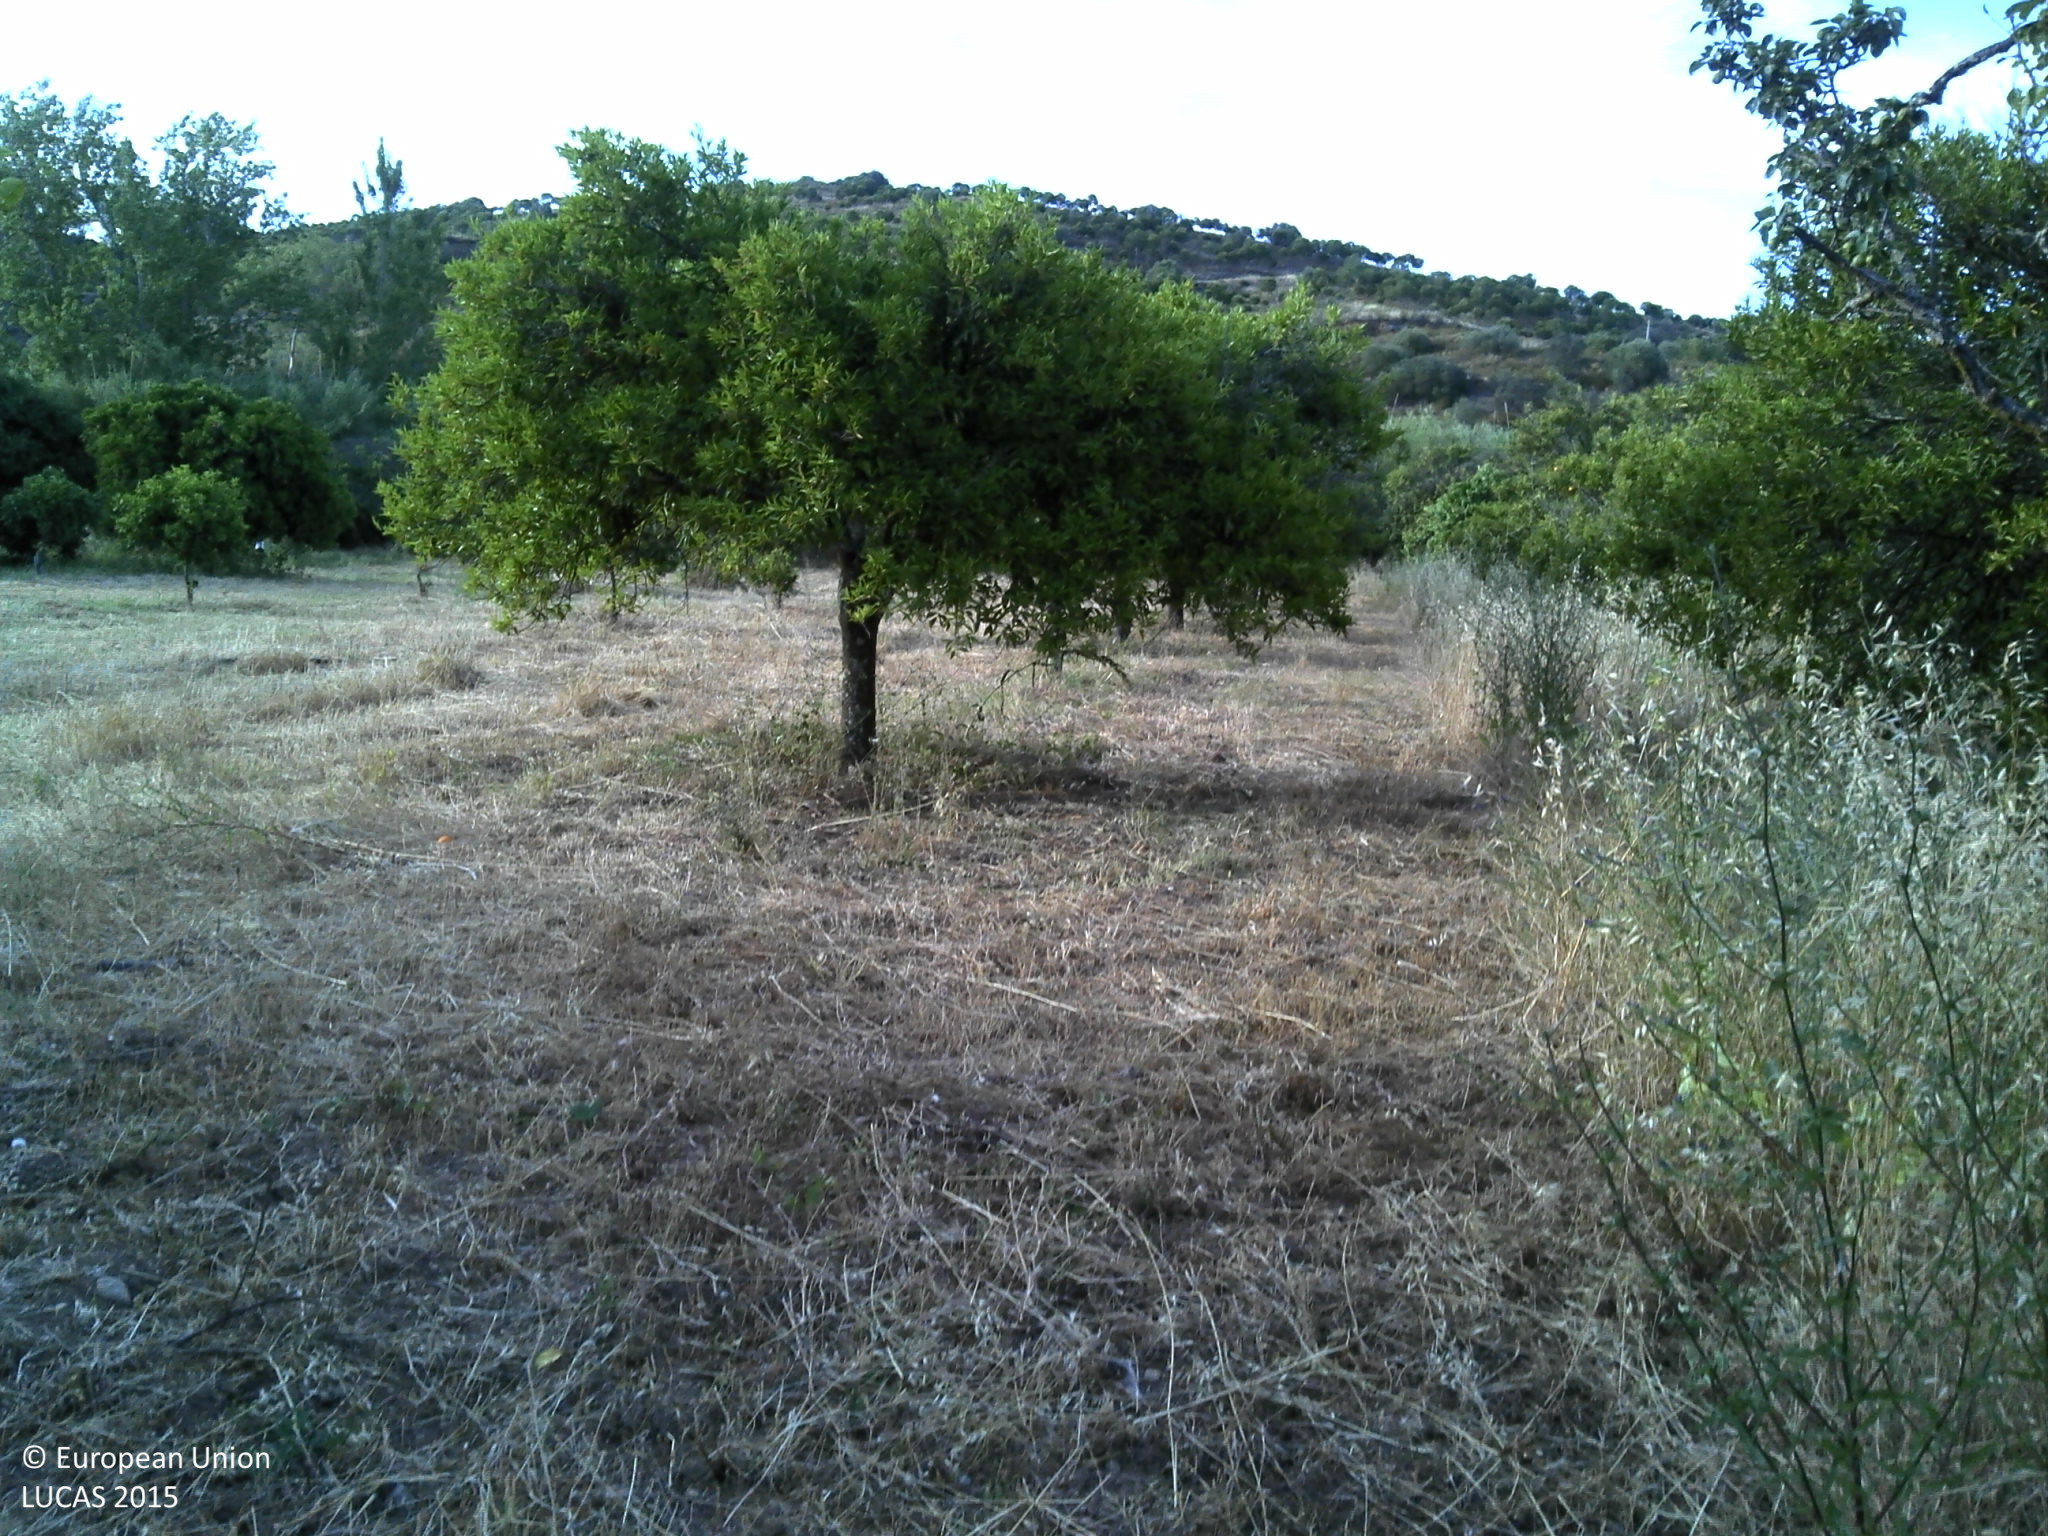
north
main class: Cropland
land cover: Other citrus fruit
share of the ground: 50 - 75 %
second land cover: Grassland without tree/shrub cover
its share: 50 - 75 %
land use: Agriculture (excluding fallow land and kitchen gardens)
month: May
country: PT
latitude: 37.2634
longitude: -7.4703
